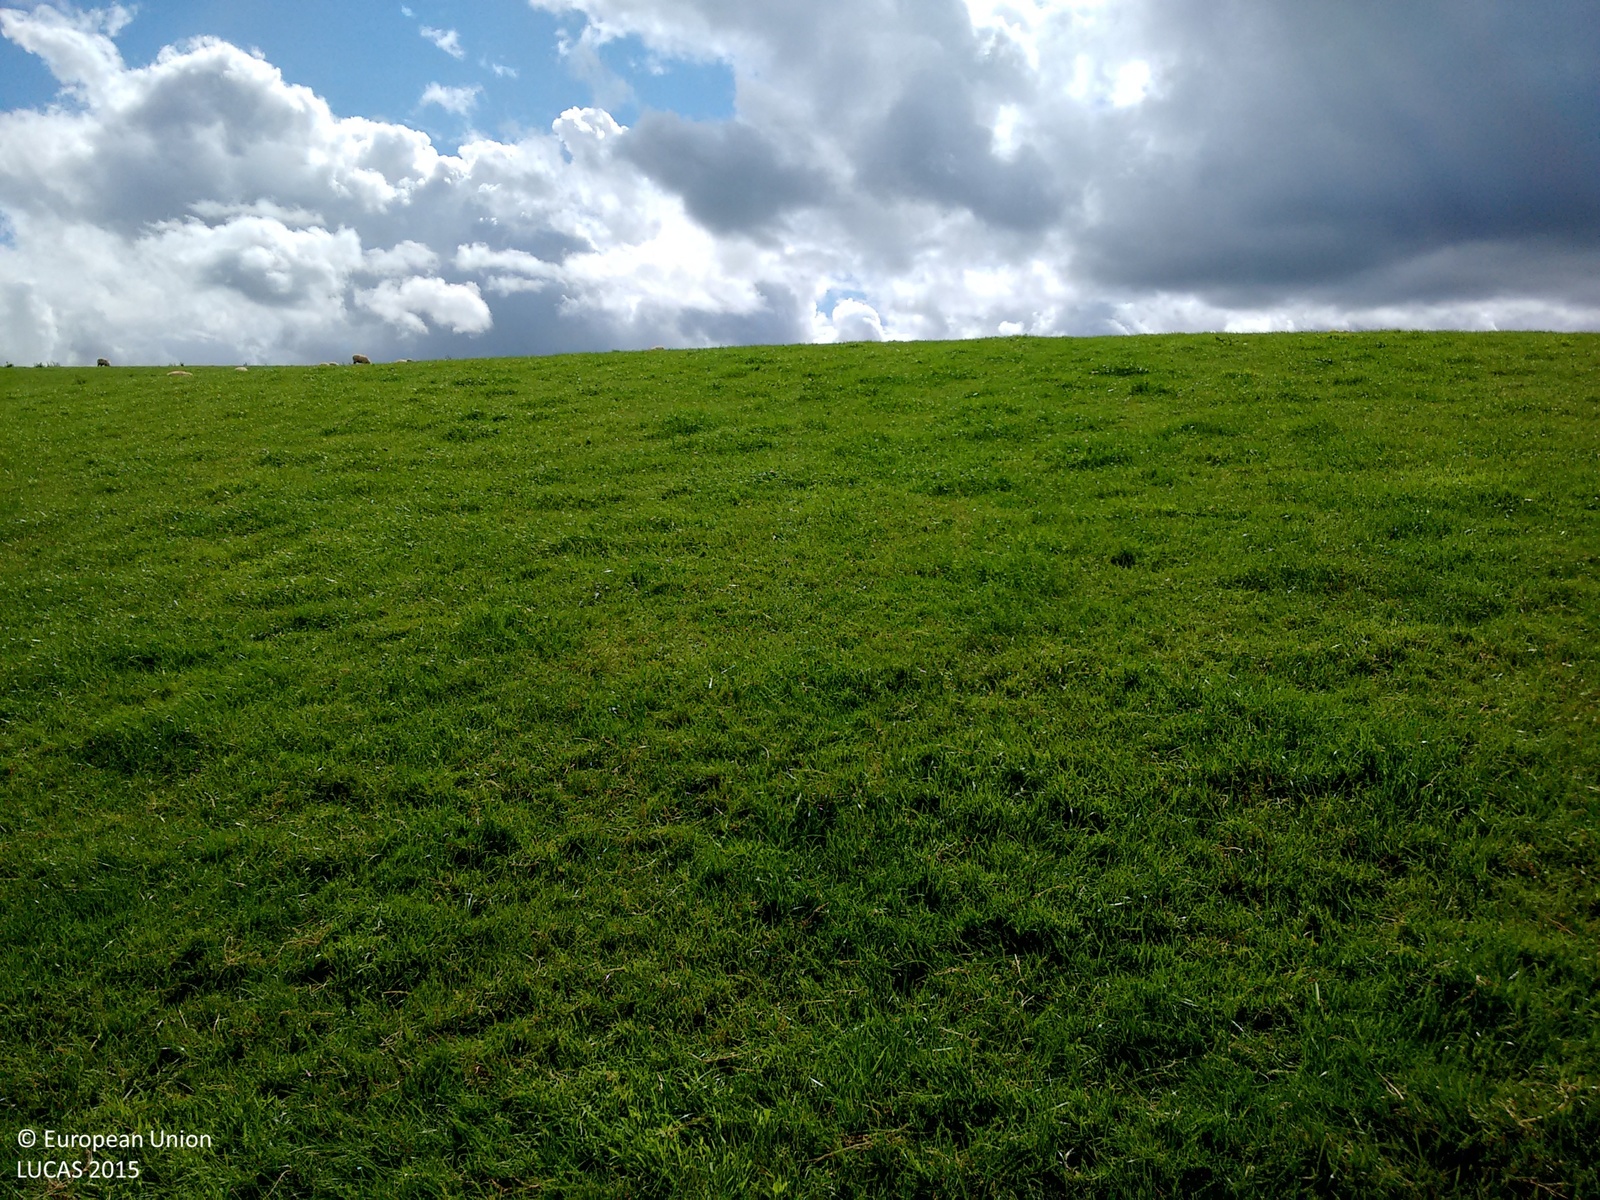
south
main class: Grassland
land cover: Grassland without tree/shrub cover
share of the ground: > 75 %
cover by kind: herbaceous plants 100 %
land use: Agriculture (excluding fallow land and kitchen gardens)
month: August
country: GB
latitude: 50.9814
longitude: -3.8072
